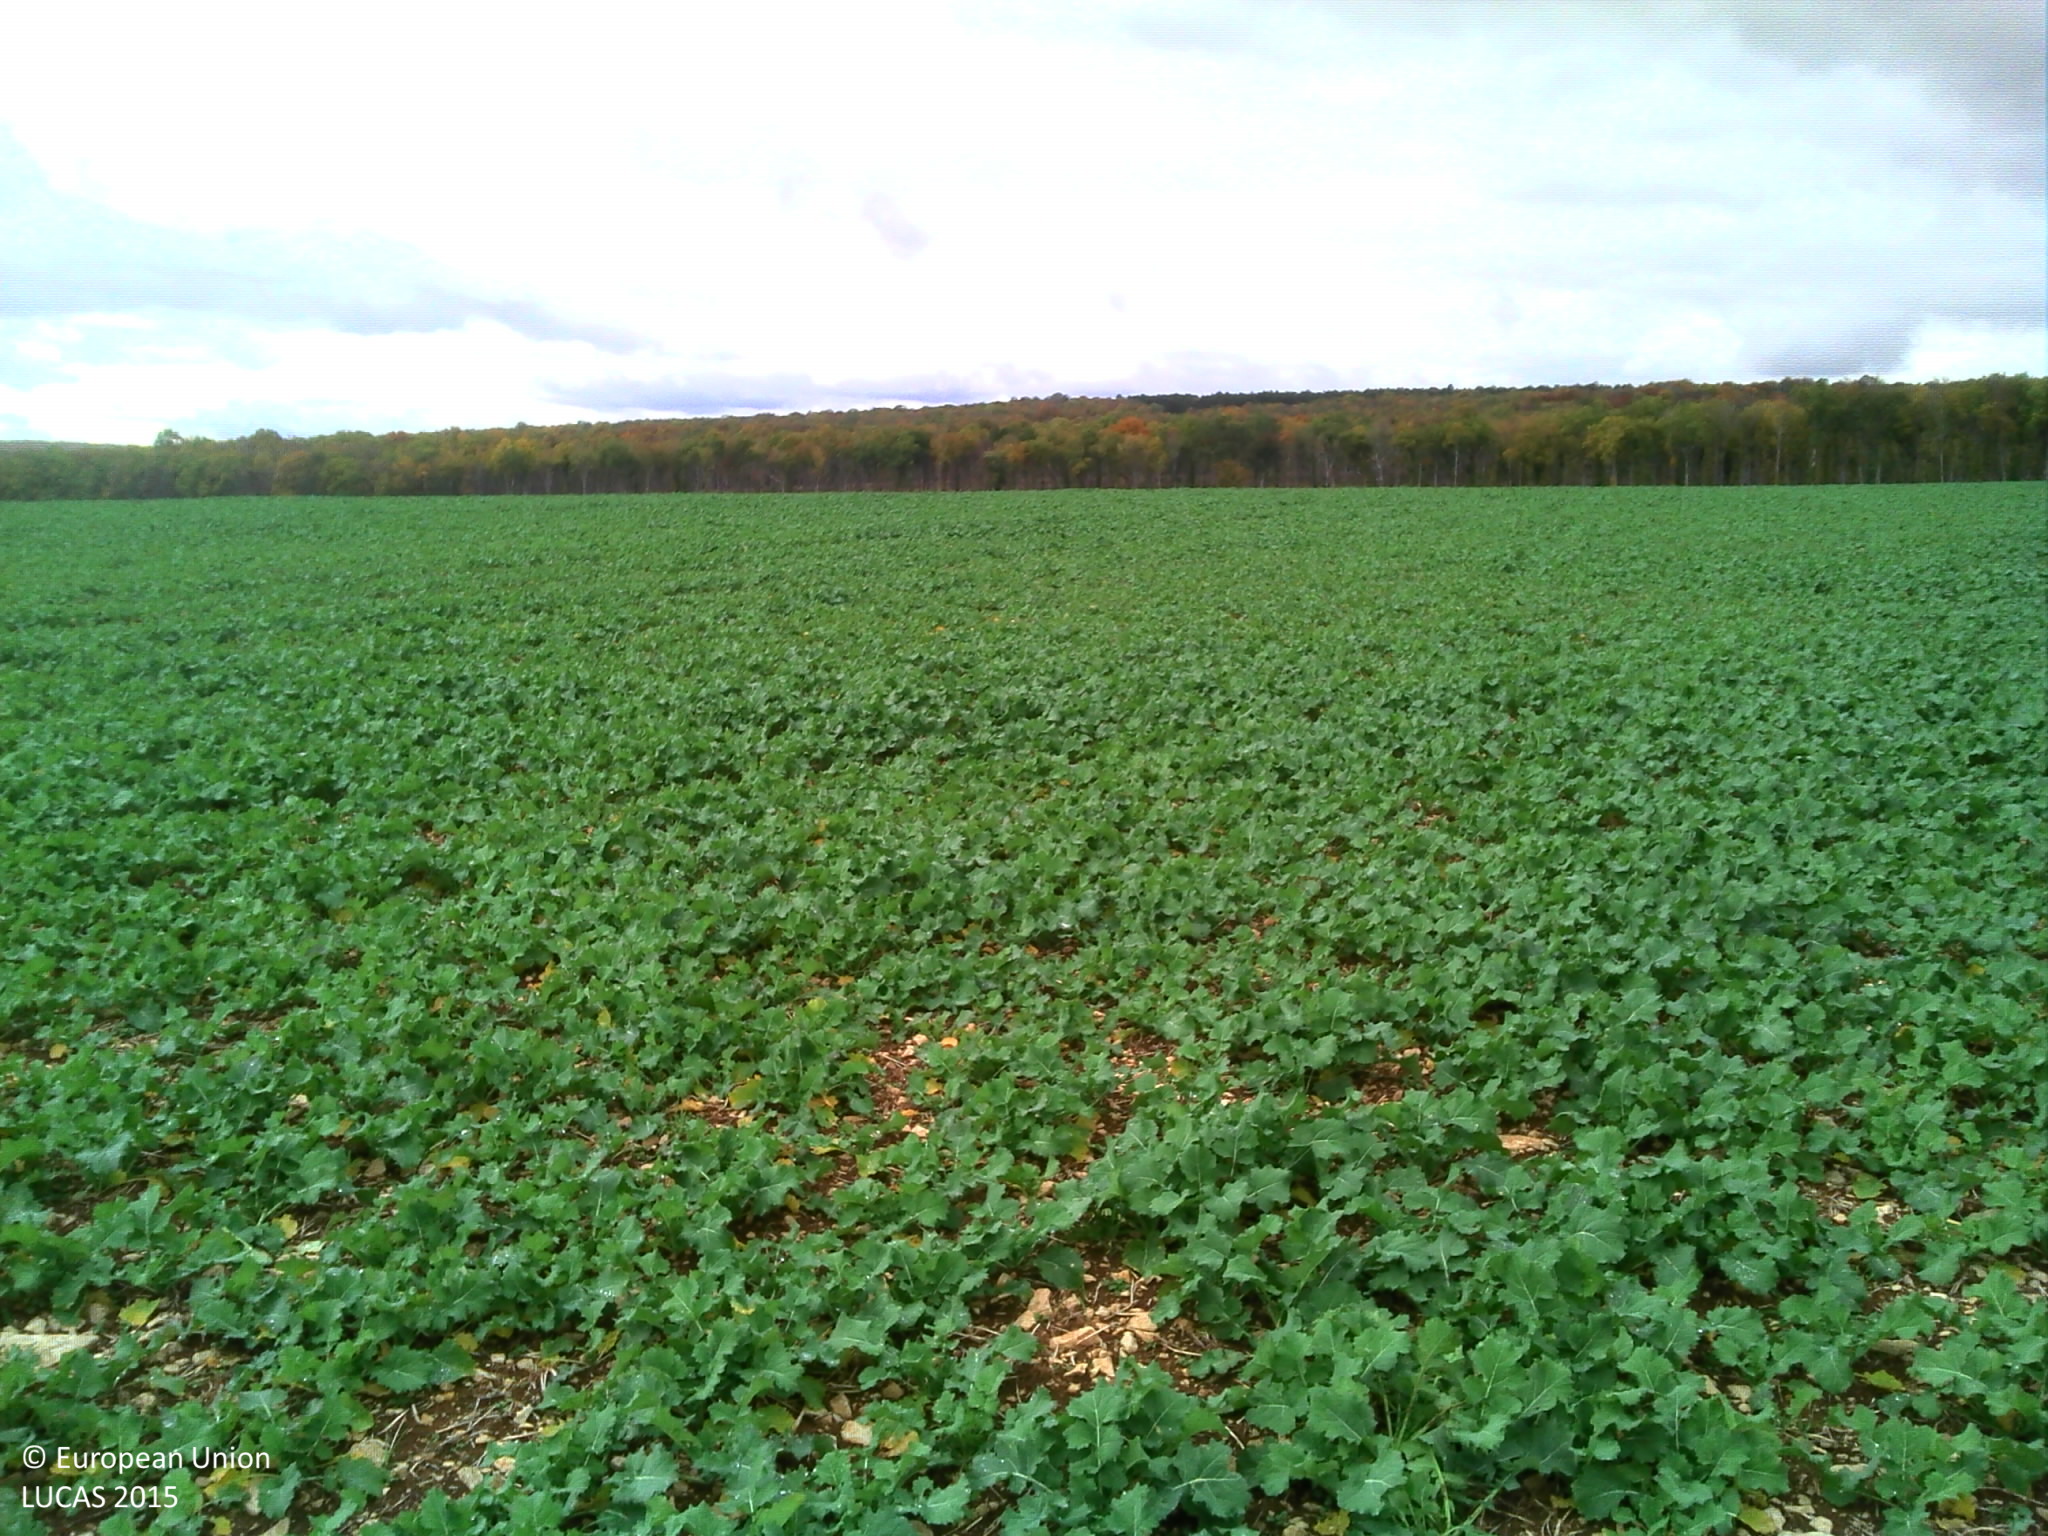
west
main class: Cropland
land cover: Rape and turnip rape
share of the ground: > 75 %
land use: Agriculture (excluding fallow land and kitchen gardens)
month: October
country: FR
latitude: 47.4189
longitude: 4.8704
